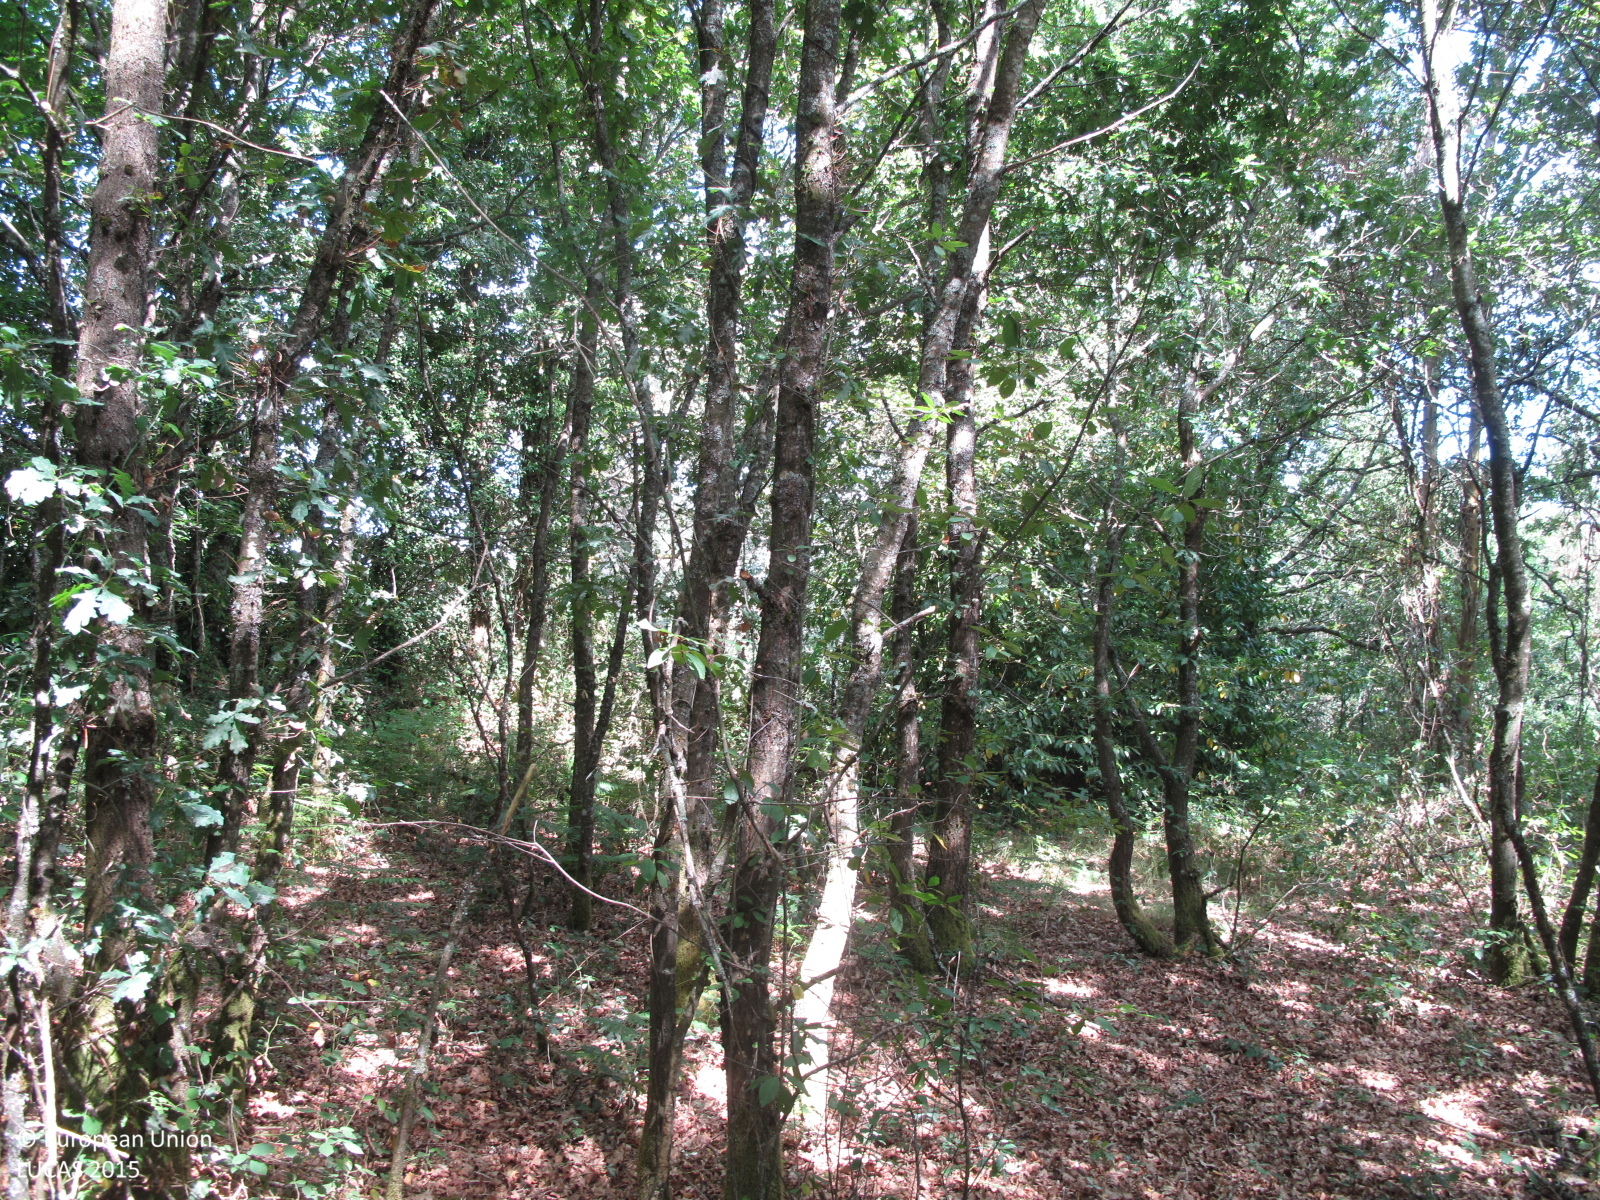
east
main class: Woodland
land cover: Broadleaved woodland
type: acidophilous oak and oak-birch forest
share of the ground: > 75 %
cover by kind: broadleaved forest trees 90 %, shrubs 5 %, herbaceous plants 5 %
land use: Semi-natural and natural areas not in use
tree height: > 5 m
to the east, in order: Broadleaved woodland; Grassland without tree/shrub cover; Broadleaved woodland; Inland fresh running water; Broadleaved woodland; Tracks; Broadleaved woodland; Grassland with sparse tree/shrub cover; Broadleaved woodland; Grassland without tree/shrub cover; Broadleaved woodland; Paved roads, cycling and walking lanes
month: July
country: ES
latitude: 43.0595
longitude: -8.0811
